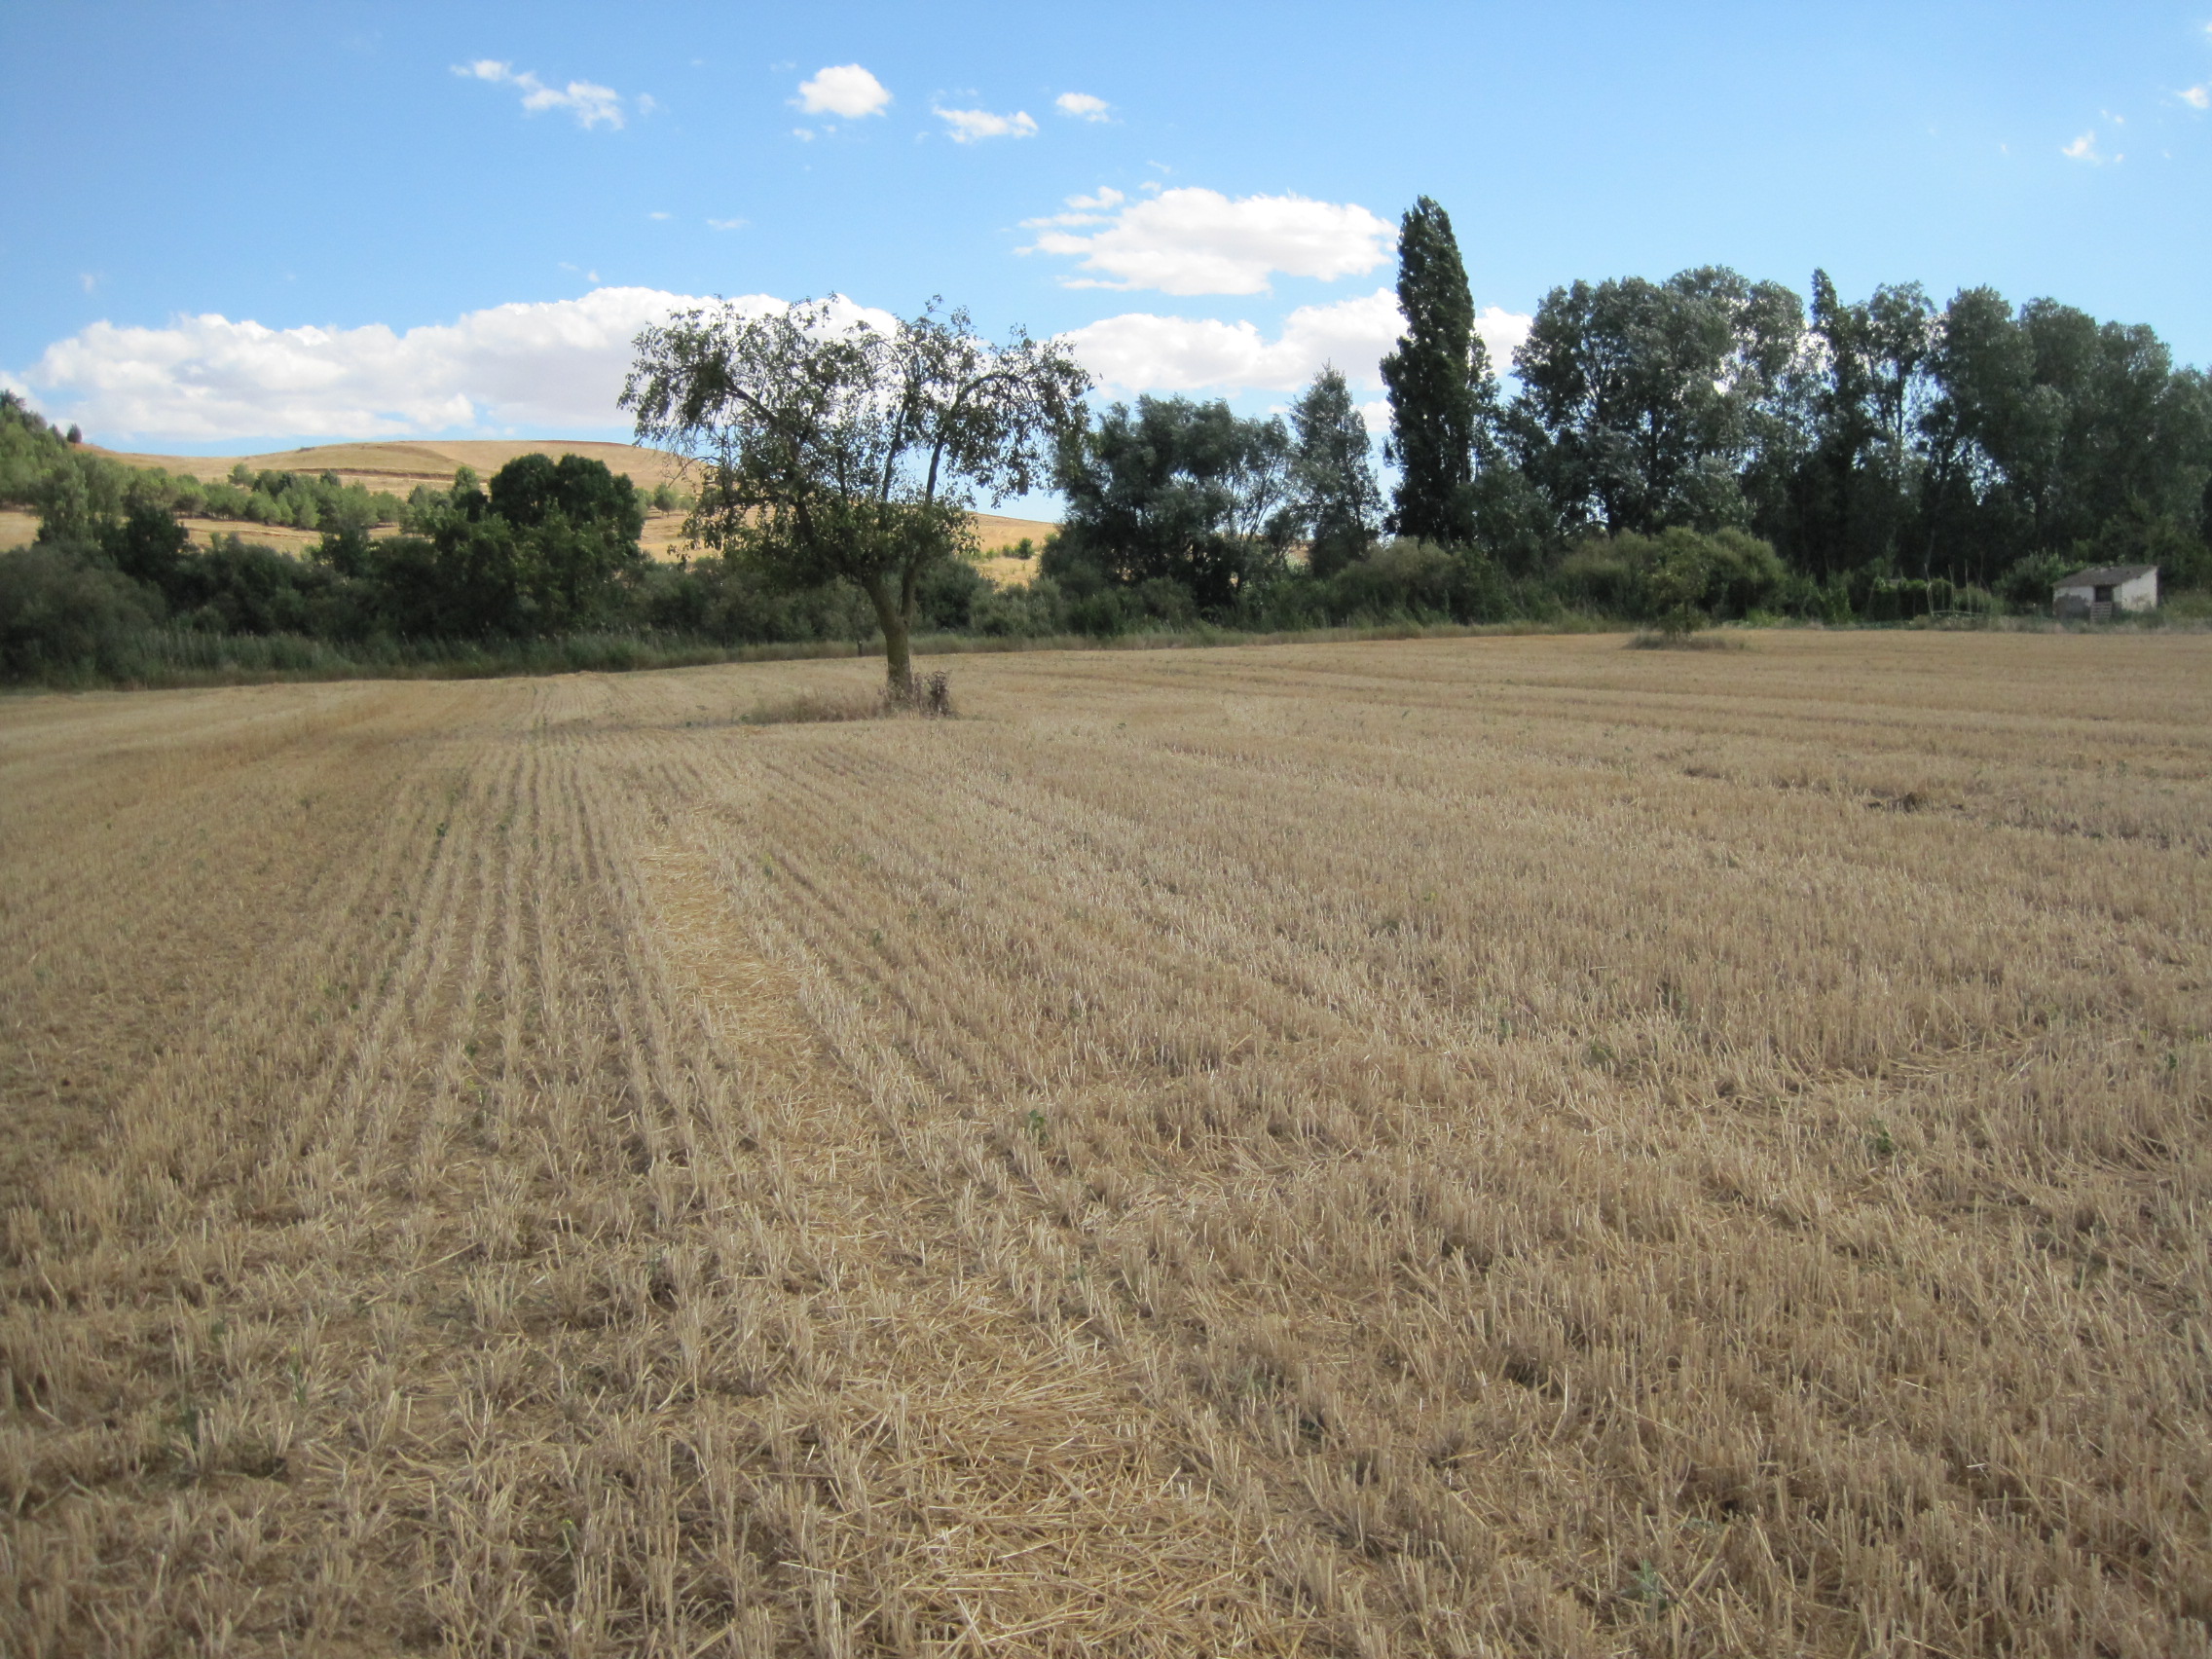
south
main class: Cropland
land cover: Common wheat
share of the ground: < 10 %
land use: Agriculture (excluding fallow land and kitchen gardens)
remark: Harvested field
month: July
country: ES
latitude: 42.0838
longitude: -5.4530
